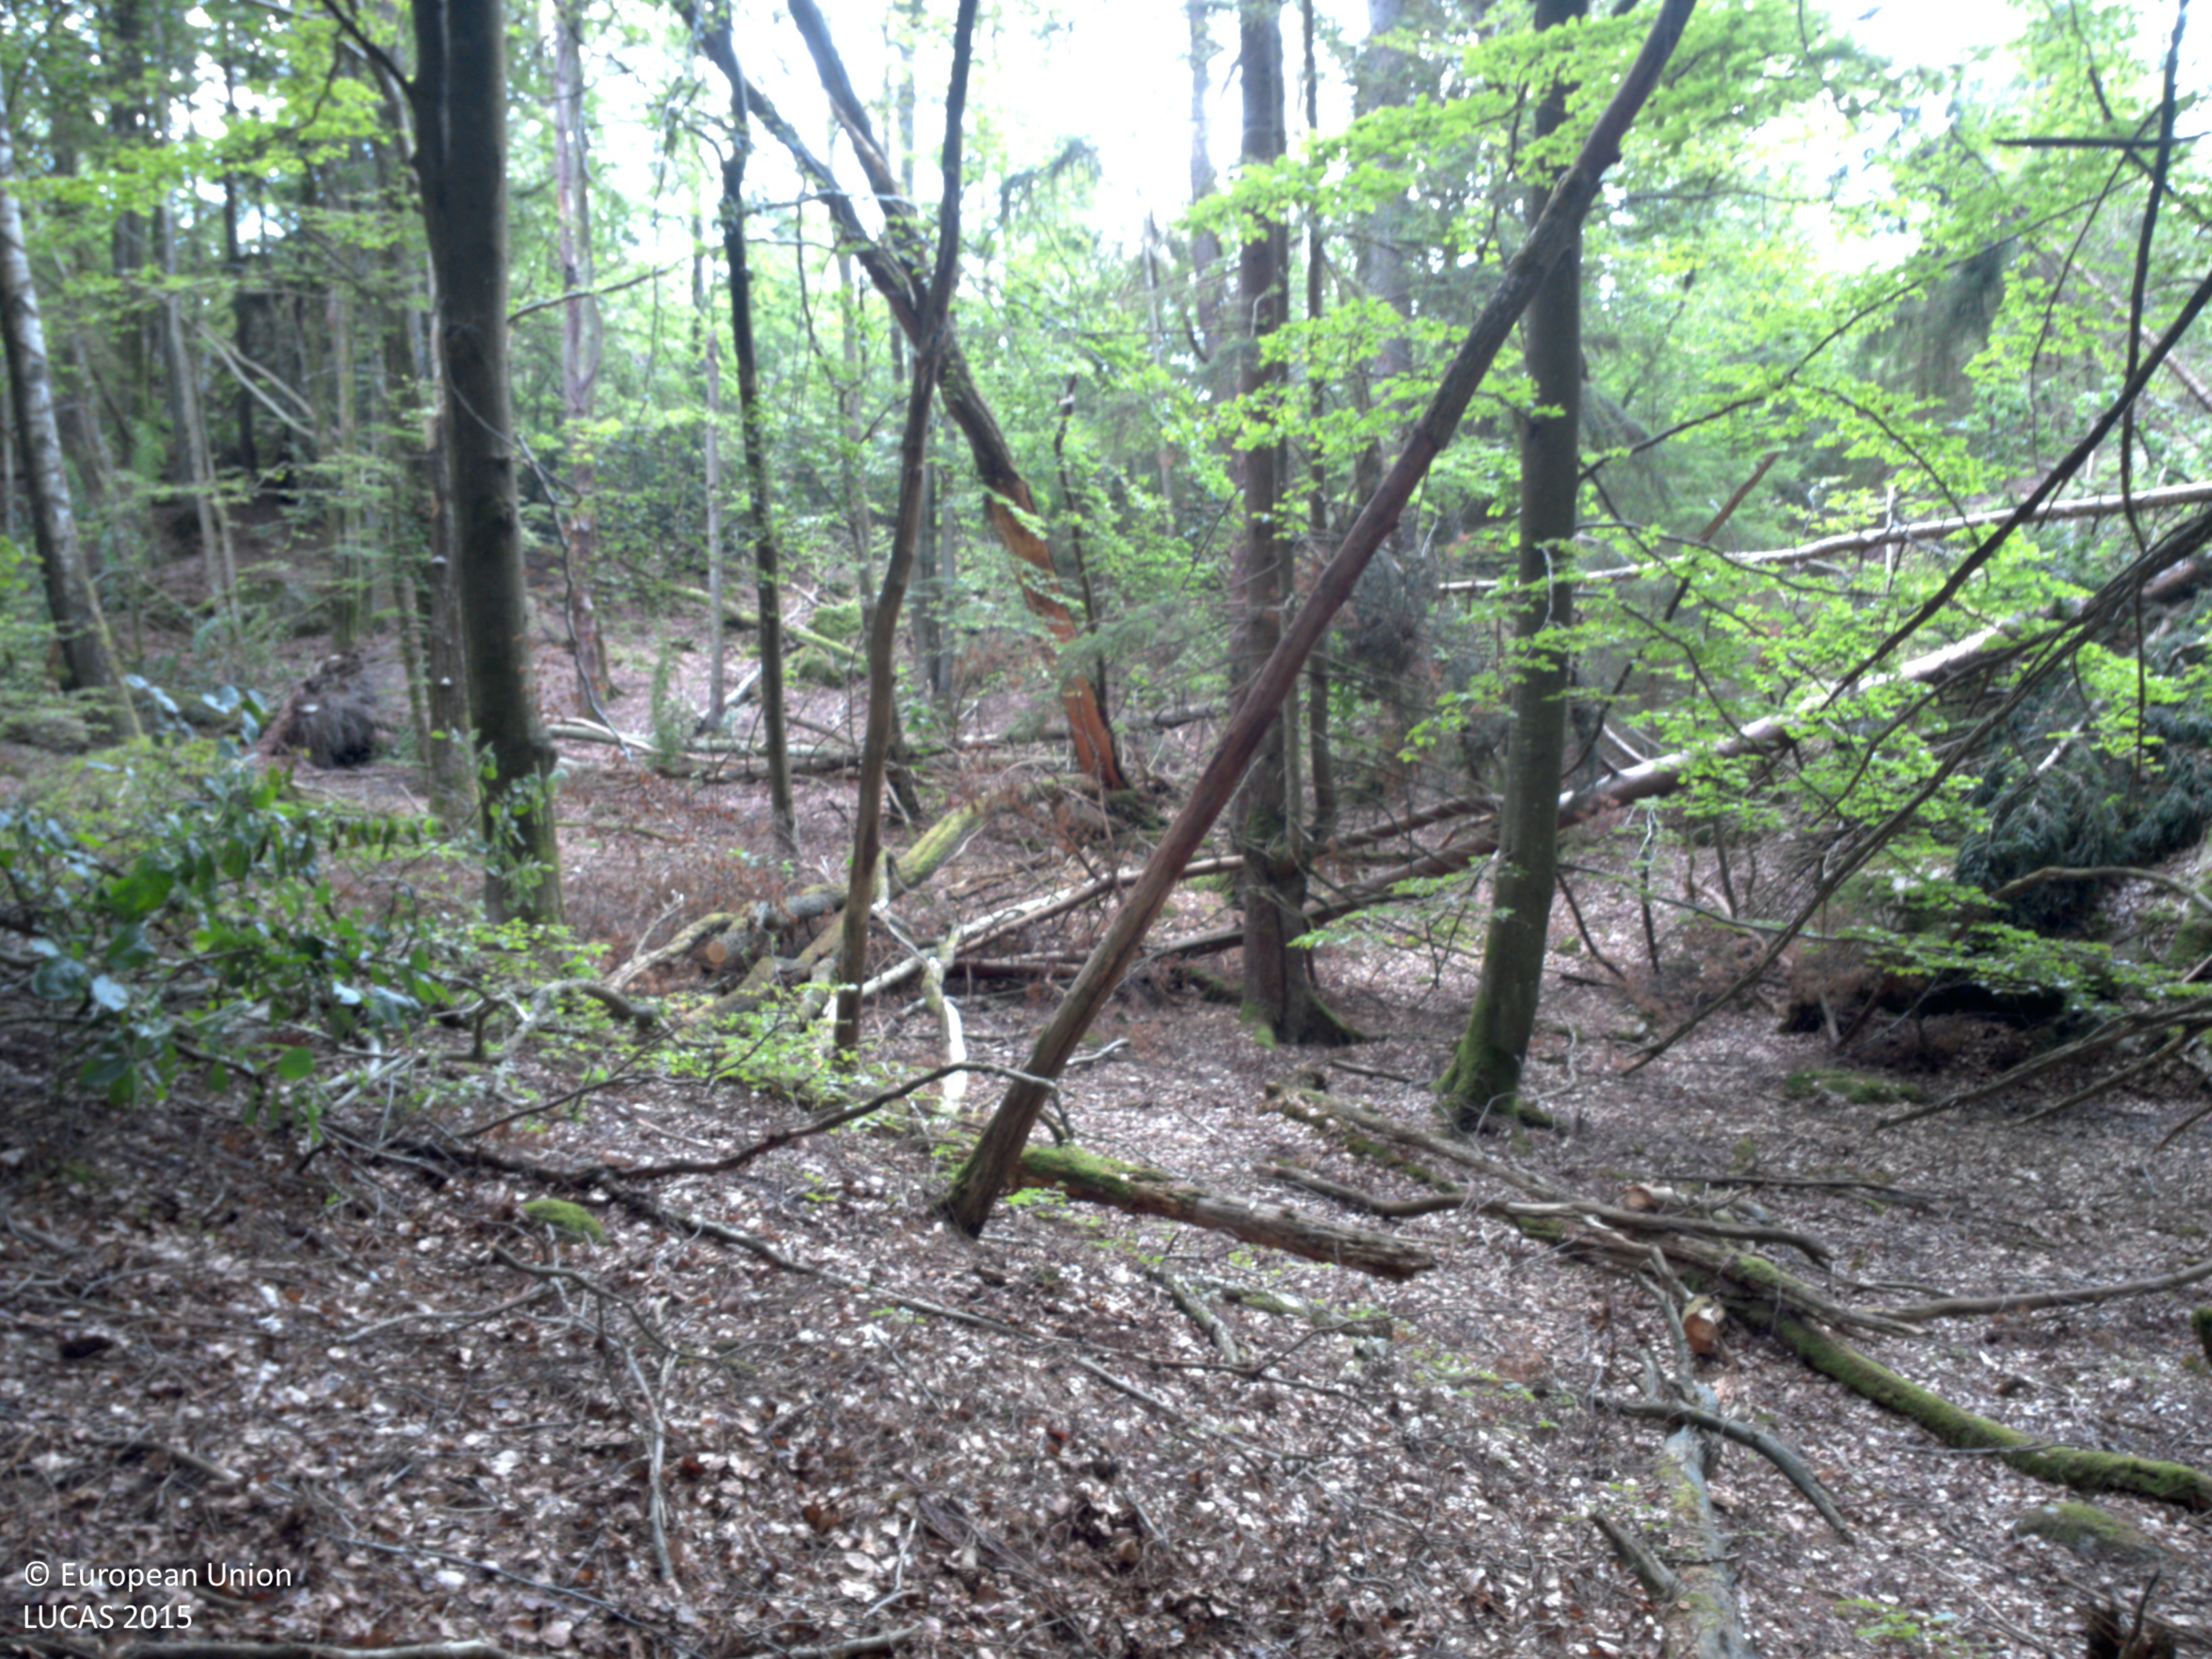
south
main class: Woodland
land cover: Spruce dominated mixed woodland
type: boreal forest
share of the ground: 50 - 75 %
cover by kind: unconsolidated bare surface 40 %, broadleaved forest trees 35 %, coniferous forest trees 20 %, shrubs 5 %
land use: Forestry
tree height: > 5 m
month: August
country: SE
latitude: 57.8652
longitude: 11.8340
